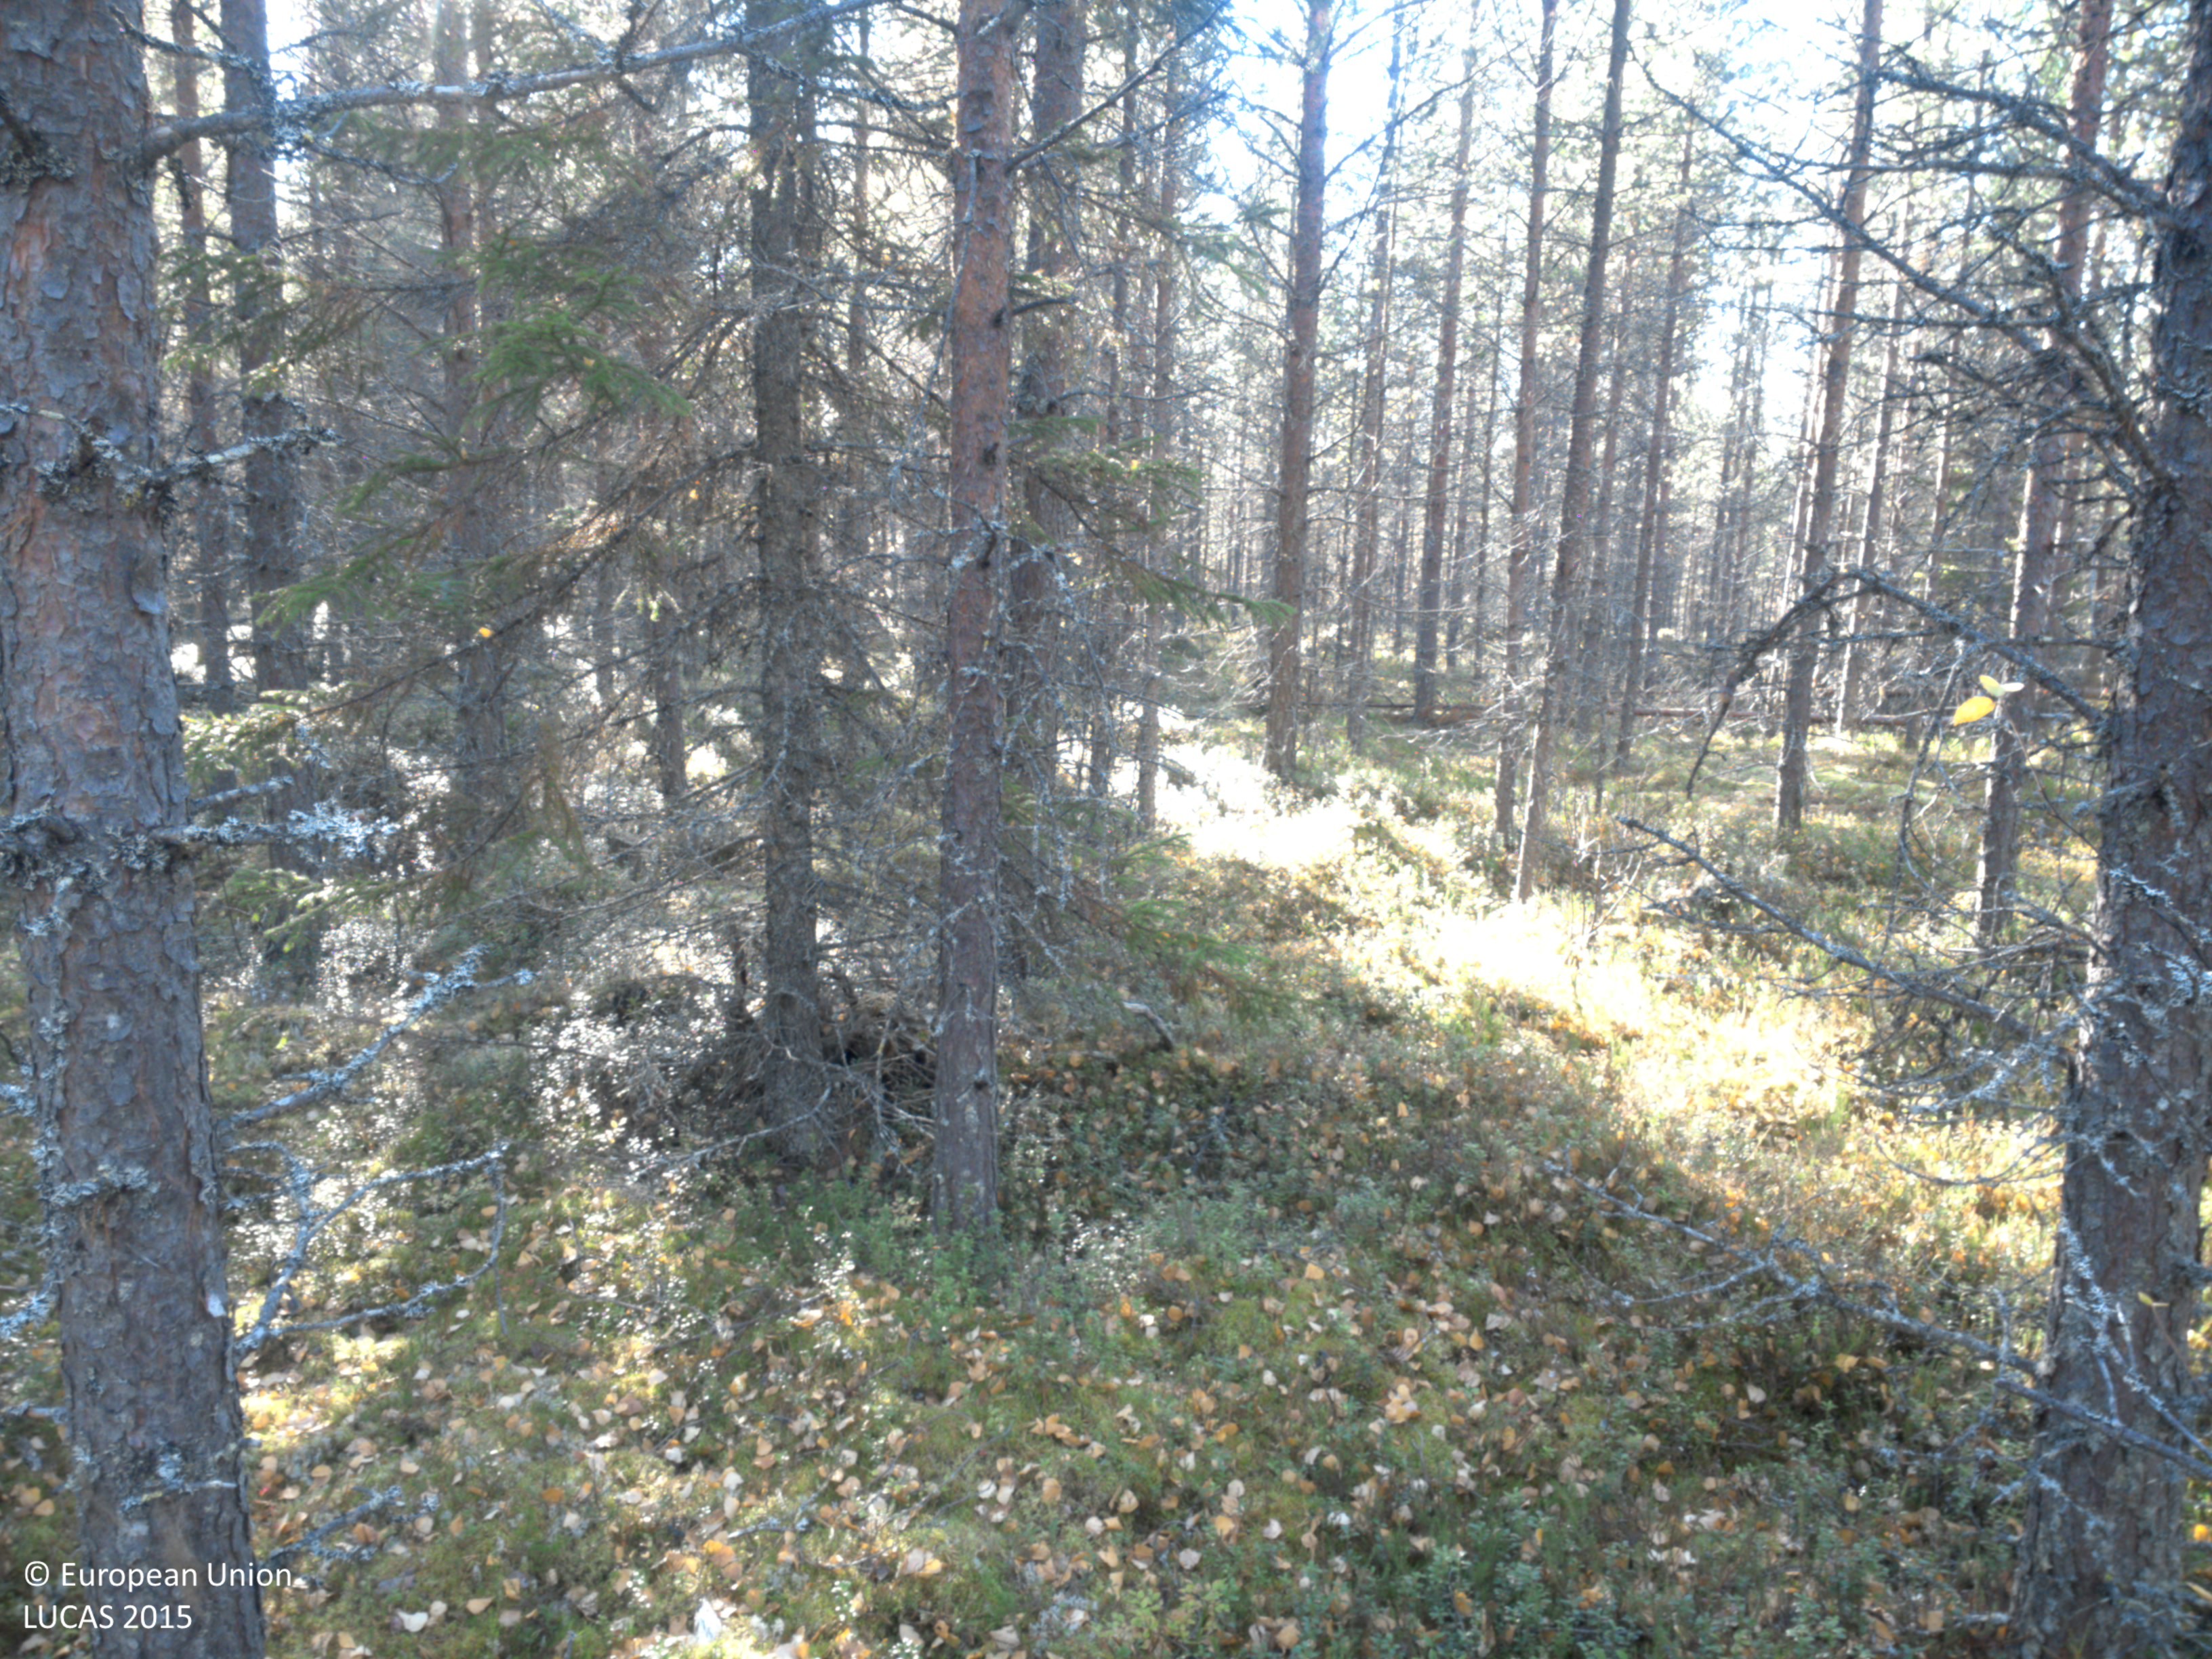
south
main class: Woodland
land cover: Pine dominated coniferous woodland
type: boreal forest
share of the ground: > 75 %
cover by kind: coniferous forest trees 80 %, shrubs 15 %, lichens and mosses 5 %
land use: Forestry
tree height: > 5 m
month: October
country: SE
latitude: 64.8134
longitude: 18.3685
